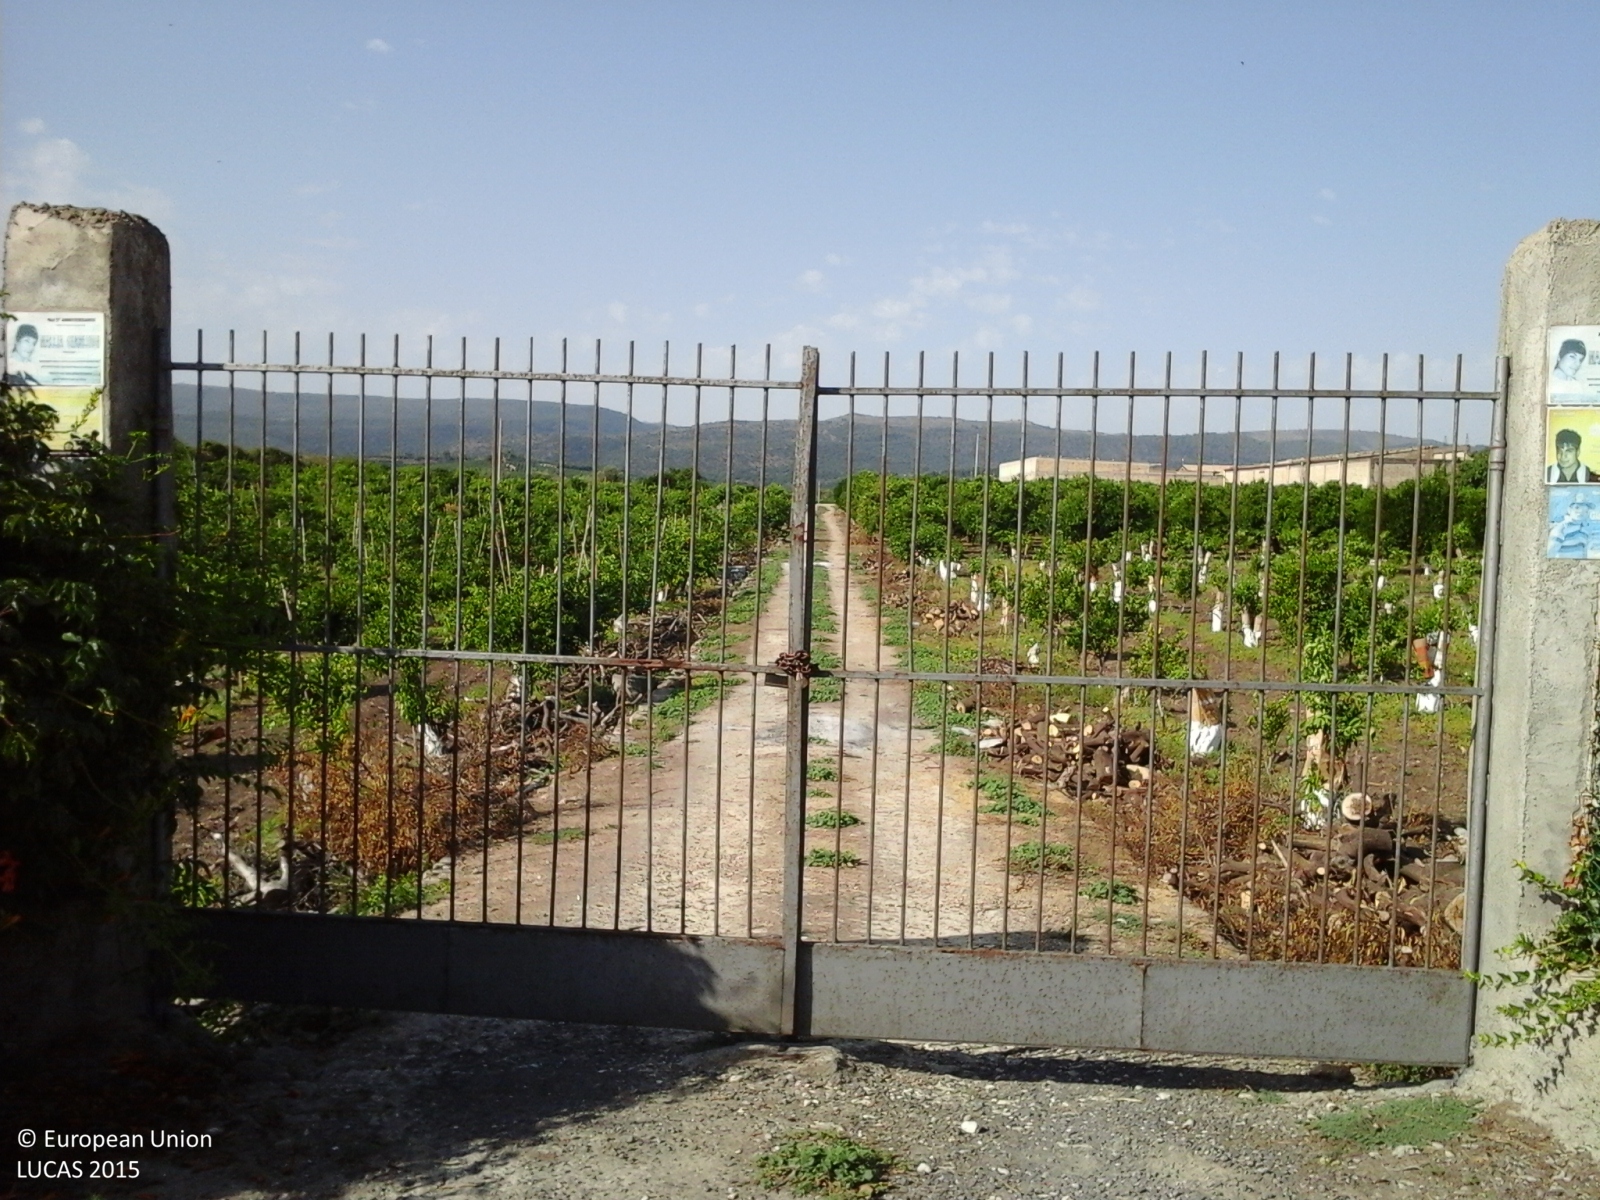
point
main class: Cropland
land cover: Oranges
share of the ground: > 75 %
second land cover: Spontaneously vegetated surfaces
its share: > 75 %
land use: Agriculture (excluding fallow land and kitchen gardens)
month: August
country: IT
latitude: 37.2217
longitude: 14.8880
